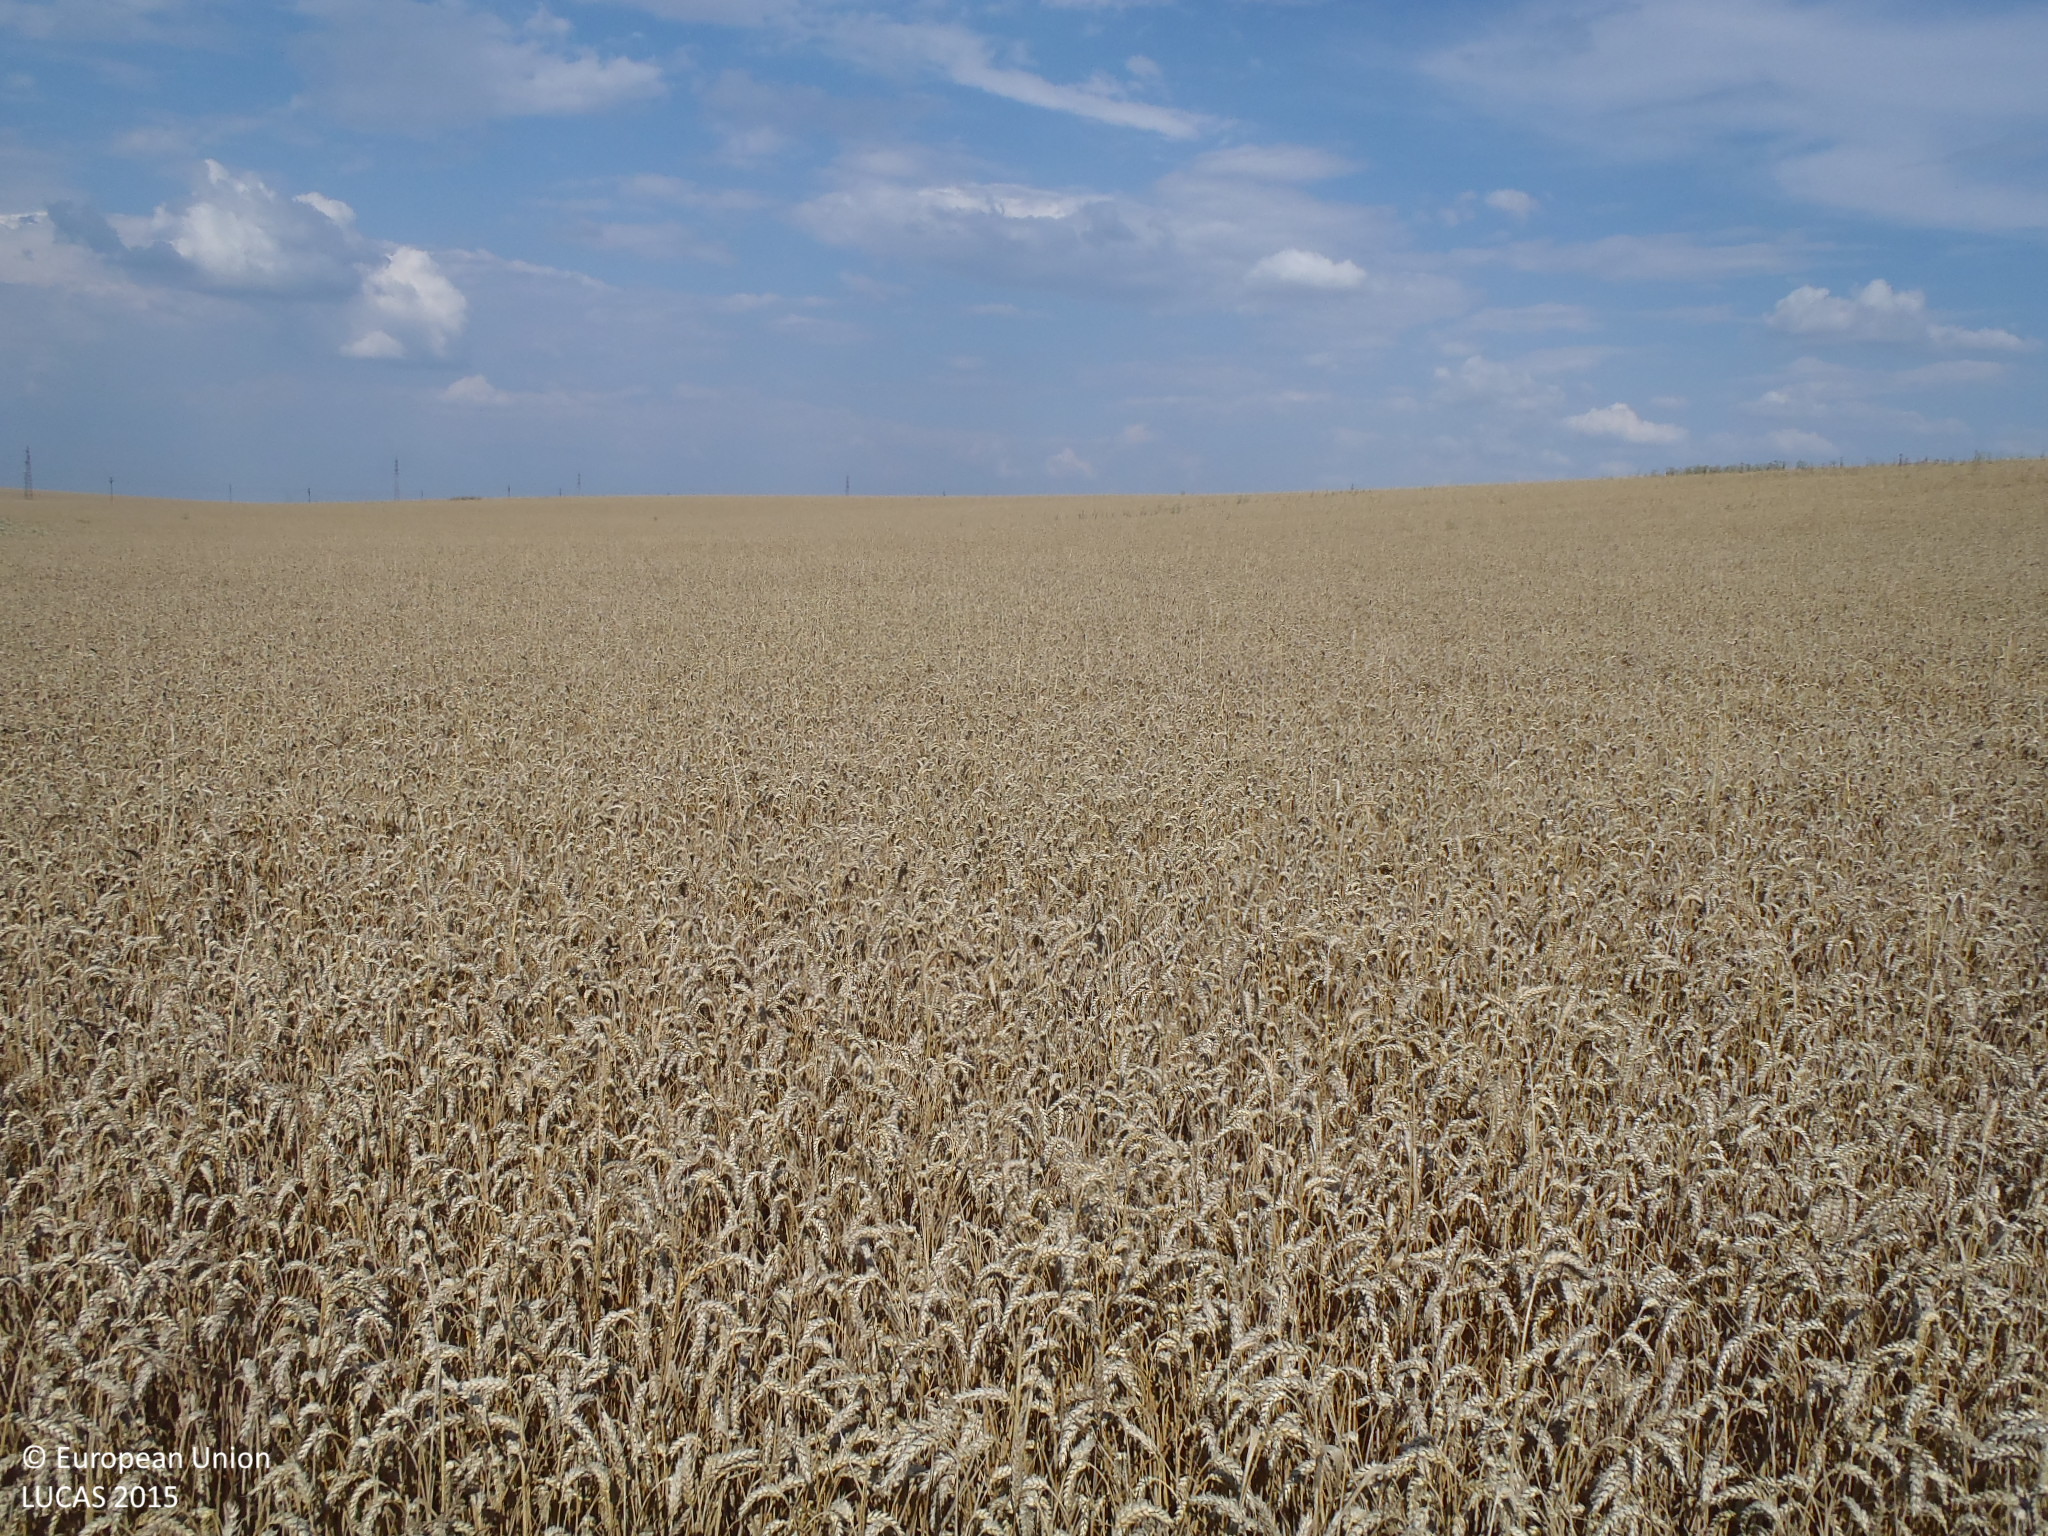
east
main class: Cropland
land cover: Common wheat
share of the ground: > 75 %
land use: Agriculture (excluding fallow land and kitchen gardens)
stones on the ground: < 10 %
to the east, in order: Common wheat
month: July
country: BG
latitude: 43.9528
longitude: 26.2915
